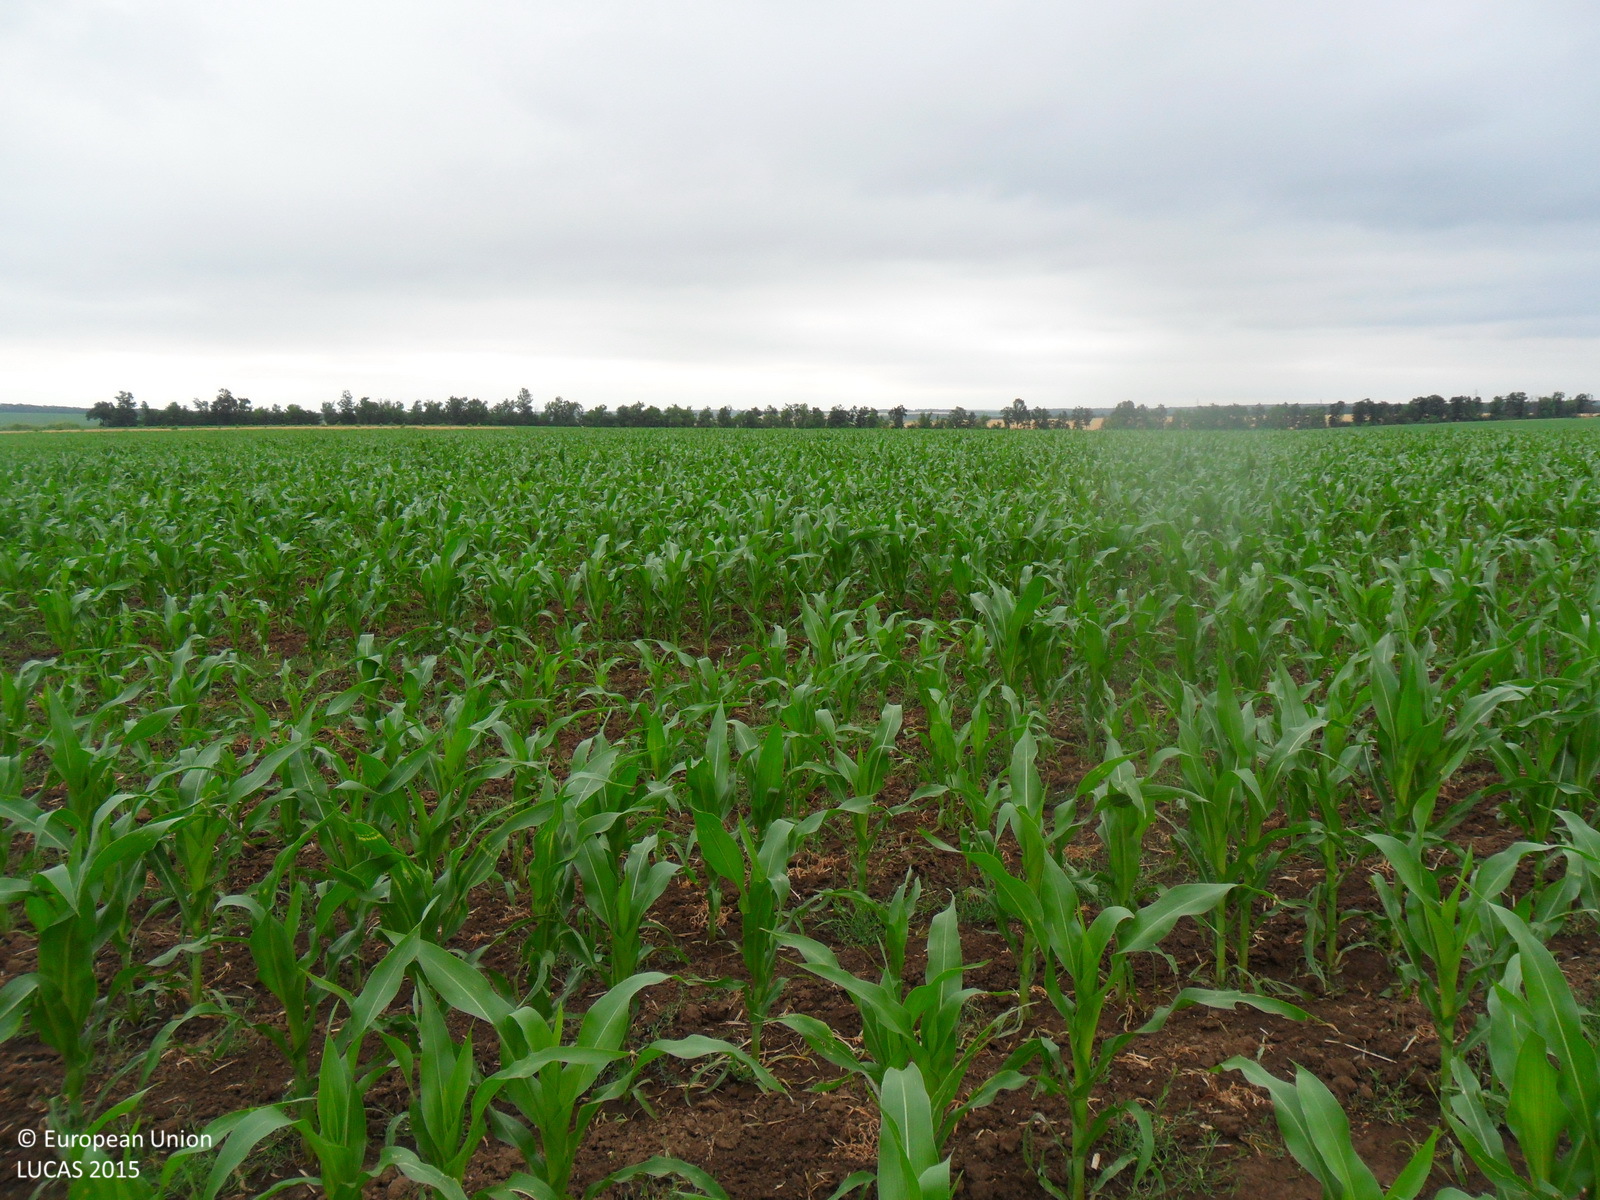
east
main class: Cropland
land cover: Maize
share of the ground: 25 - 50 %
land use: Agriculture (excluding fallow land and kitchen gardens)
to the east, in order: Maize
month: June
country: BG
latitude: 43.7453
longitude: 26.6646
